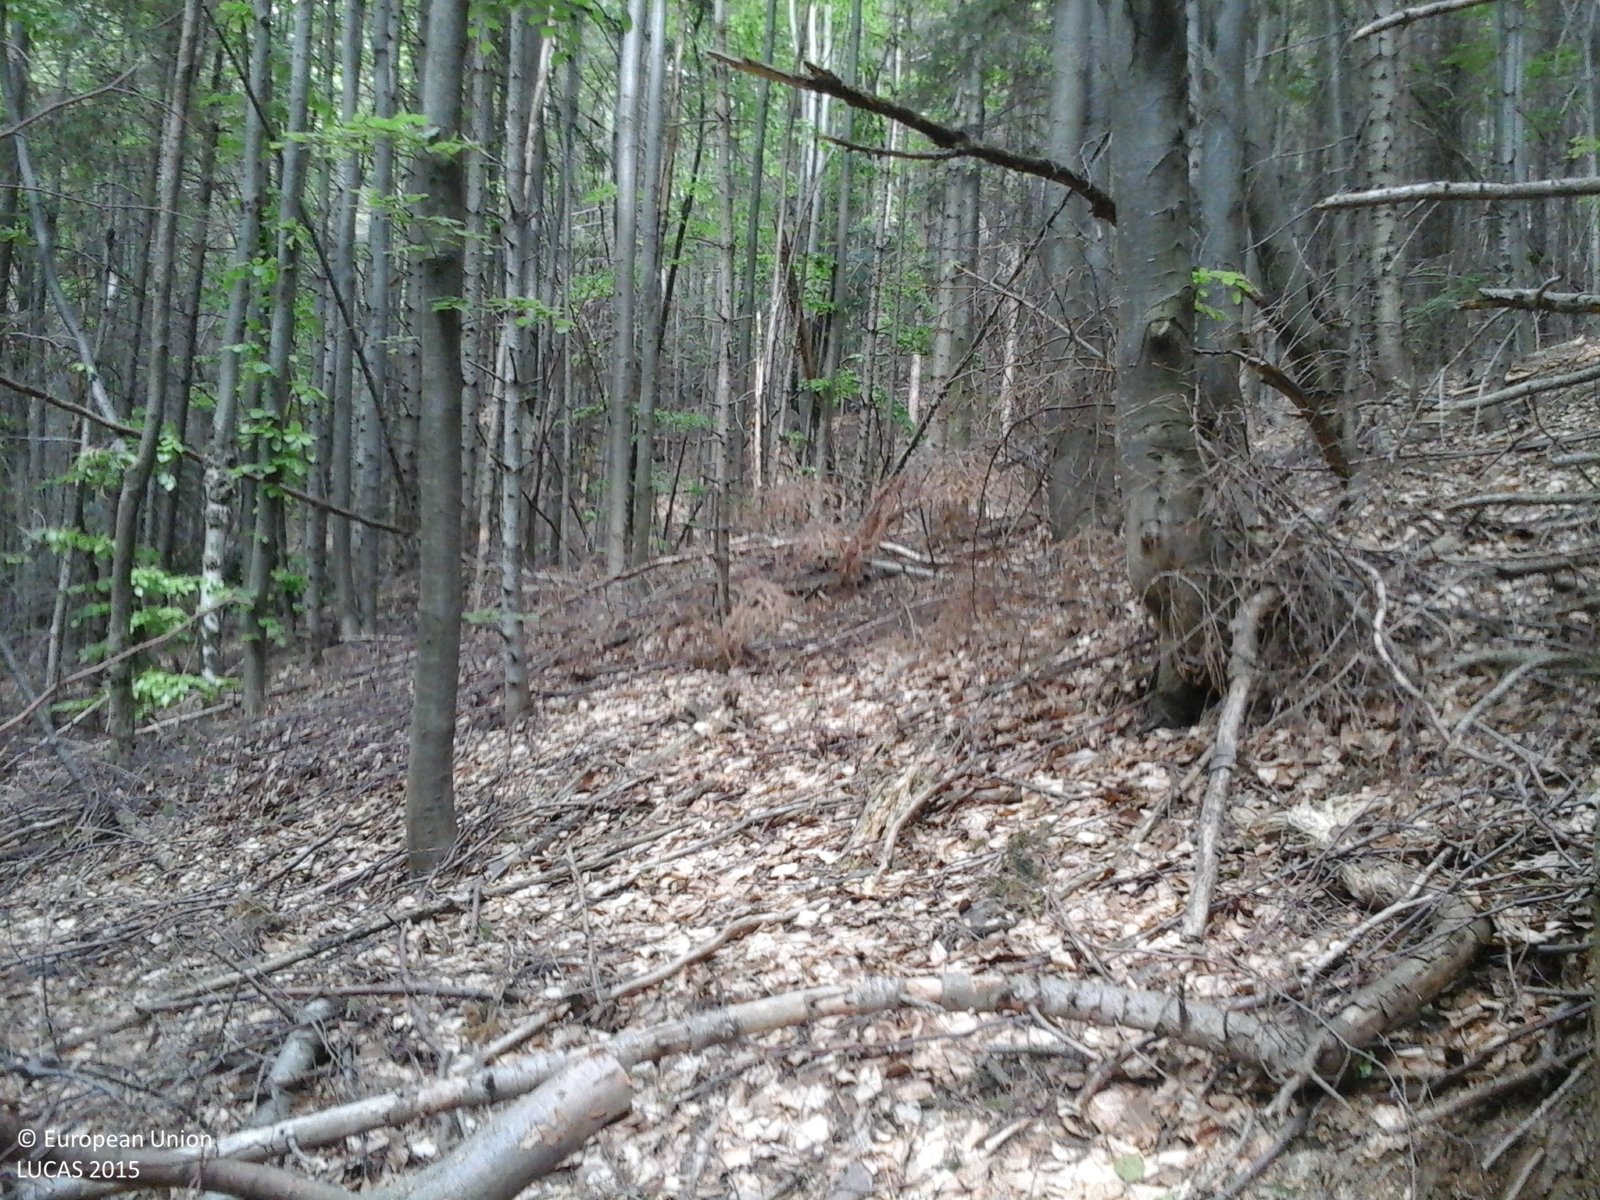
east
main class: Woodland
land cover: Other mixed woodland
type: mountainous beech forest
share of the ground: > 75 %
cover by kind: coniferous forest trees 60 %, broadleaved forest trees 40 %
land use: Forestry
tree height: > 5 m
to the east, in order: Other mixed woodland
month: May
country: RO
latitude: 46.0965
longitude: 26.4401
